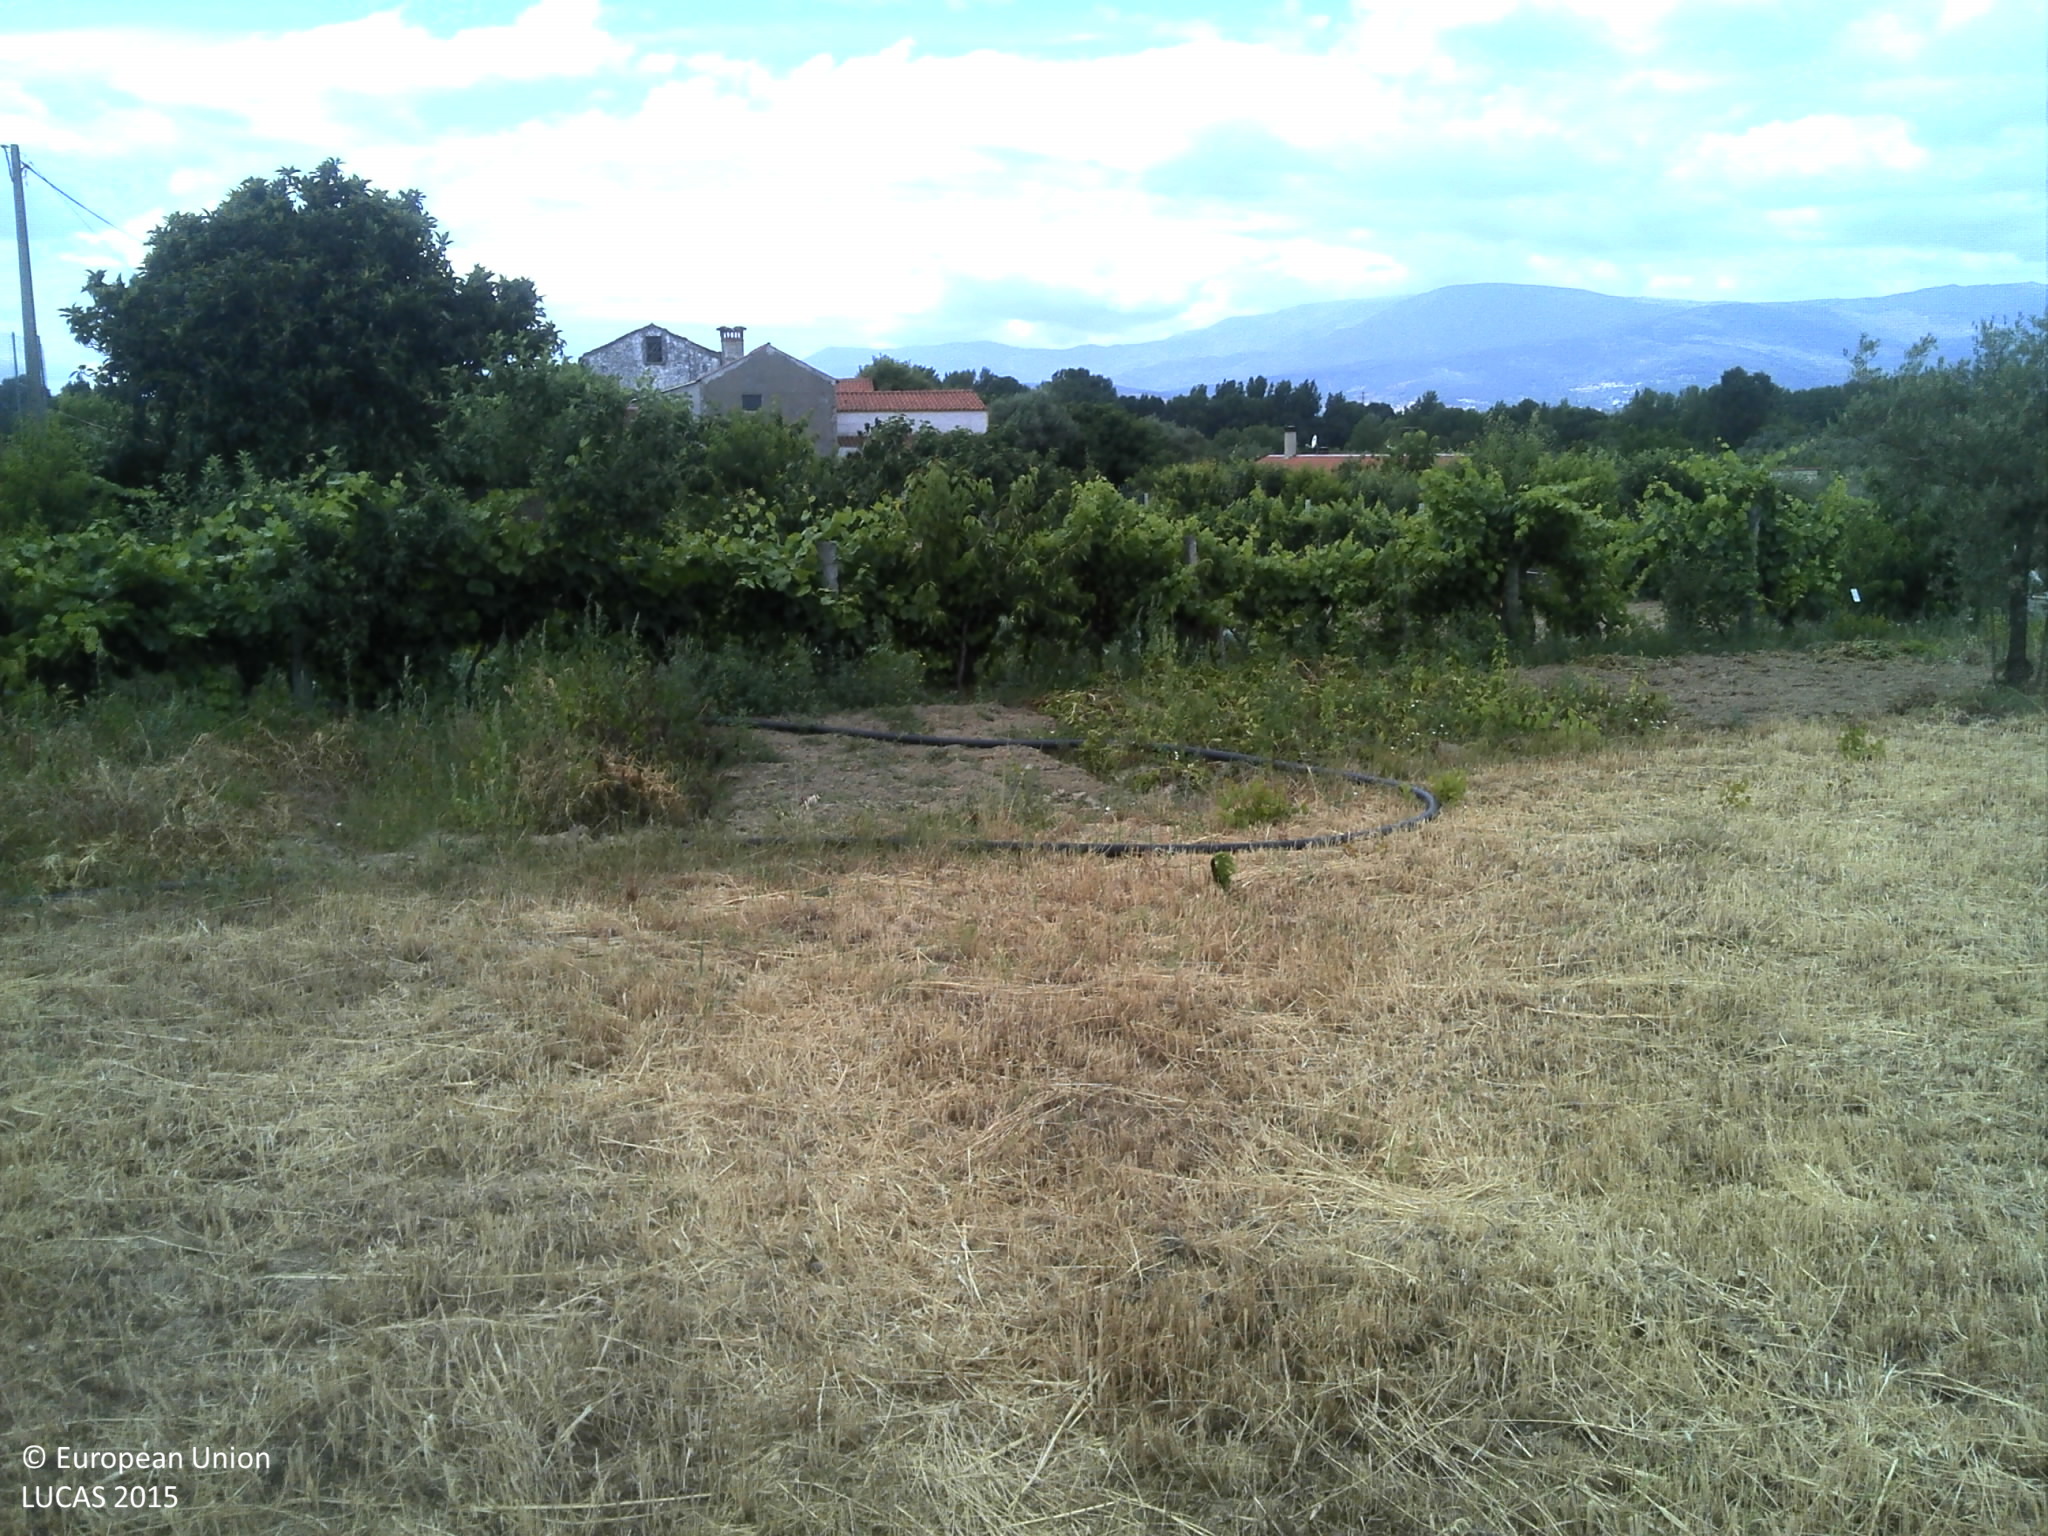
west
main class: Cropland
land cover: Oats
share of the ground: < 10 %
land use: Agriculture (excluding fallow land and kitchen gardens)
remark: Harvested field
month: June
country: PT
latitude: 40.1627
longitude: -7.4697
